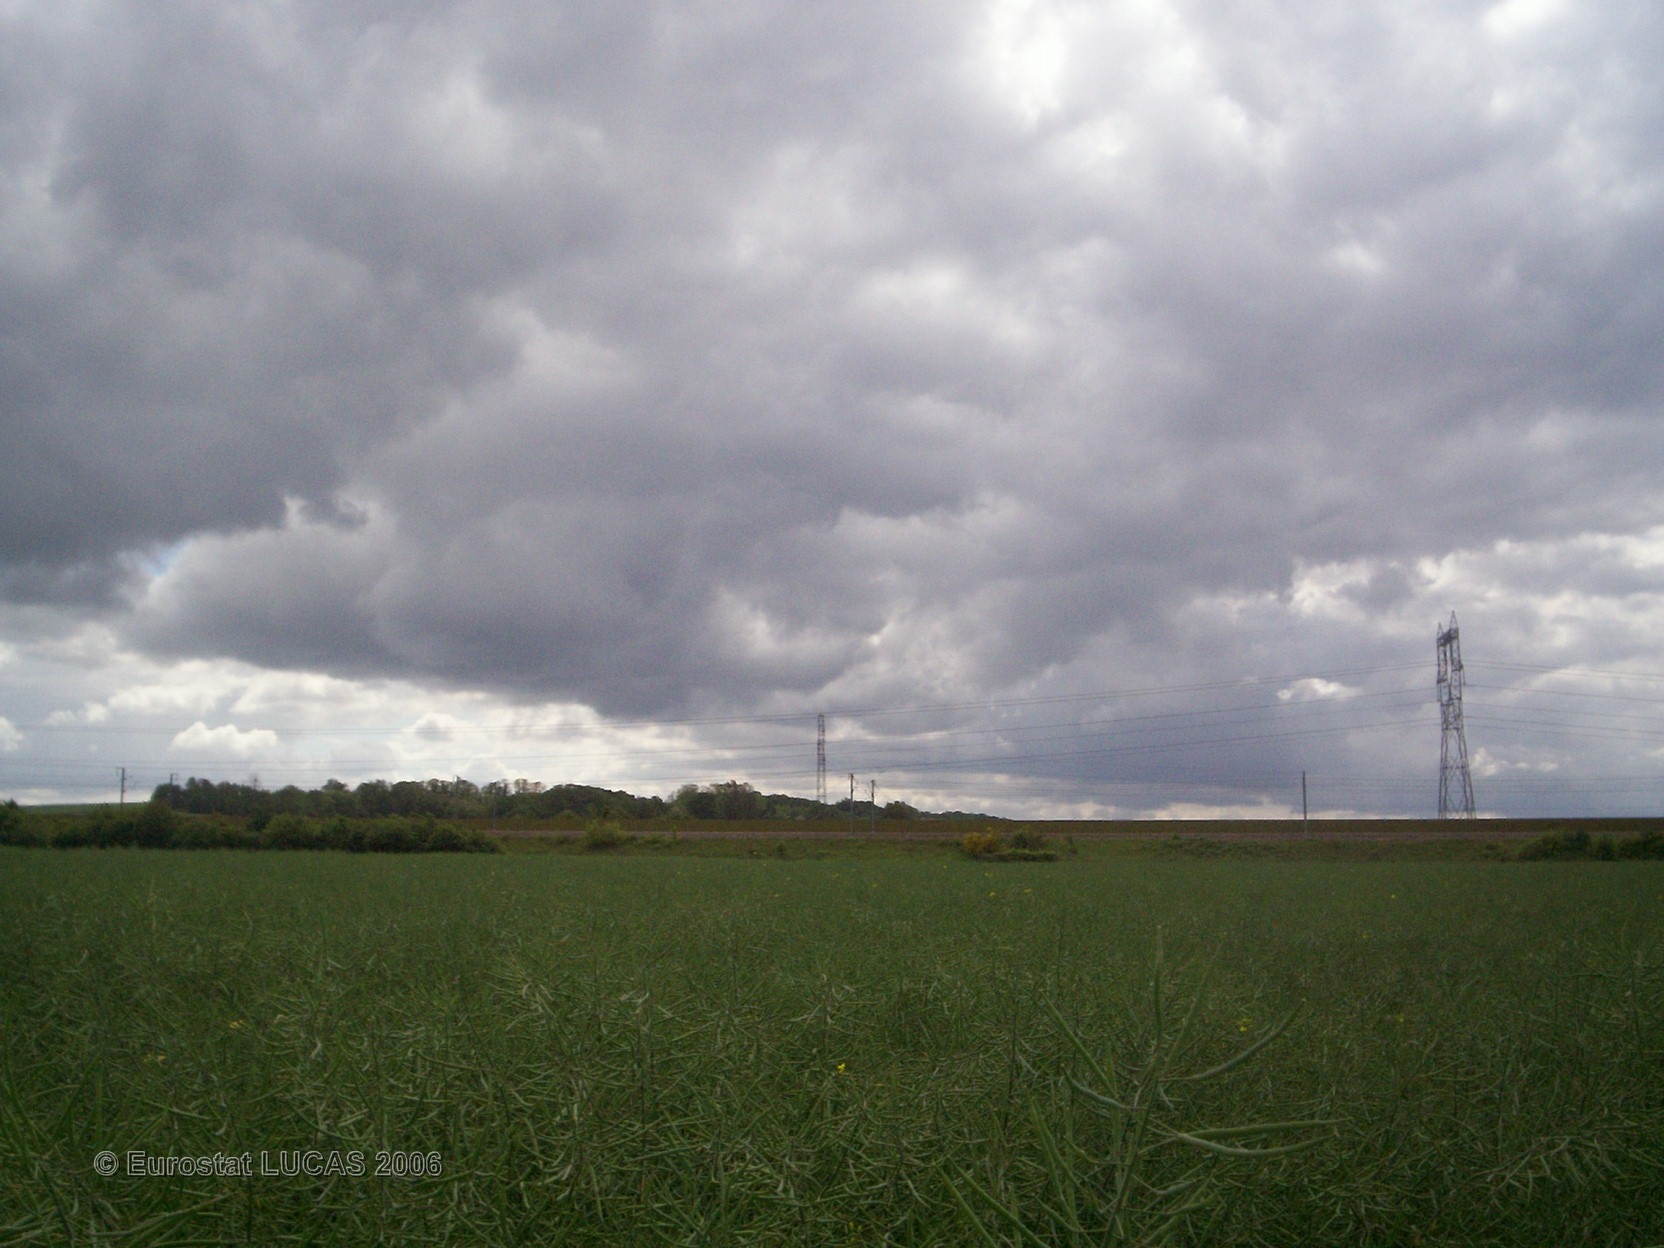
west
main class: Cropland
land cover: Rape and turnip rape
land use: Agriculture (excluding fallow land and kitchen gardens)
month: May
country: FR
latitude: 49.2133
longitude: 2.7551
